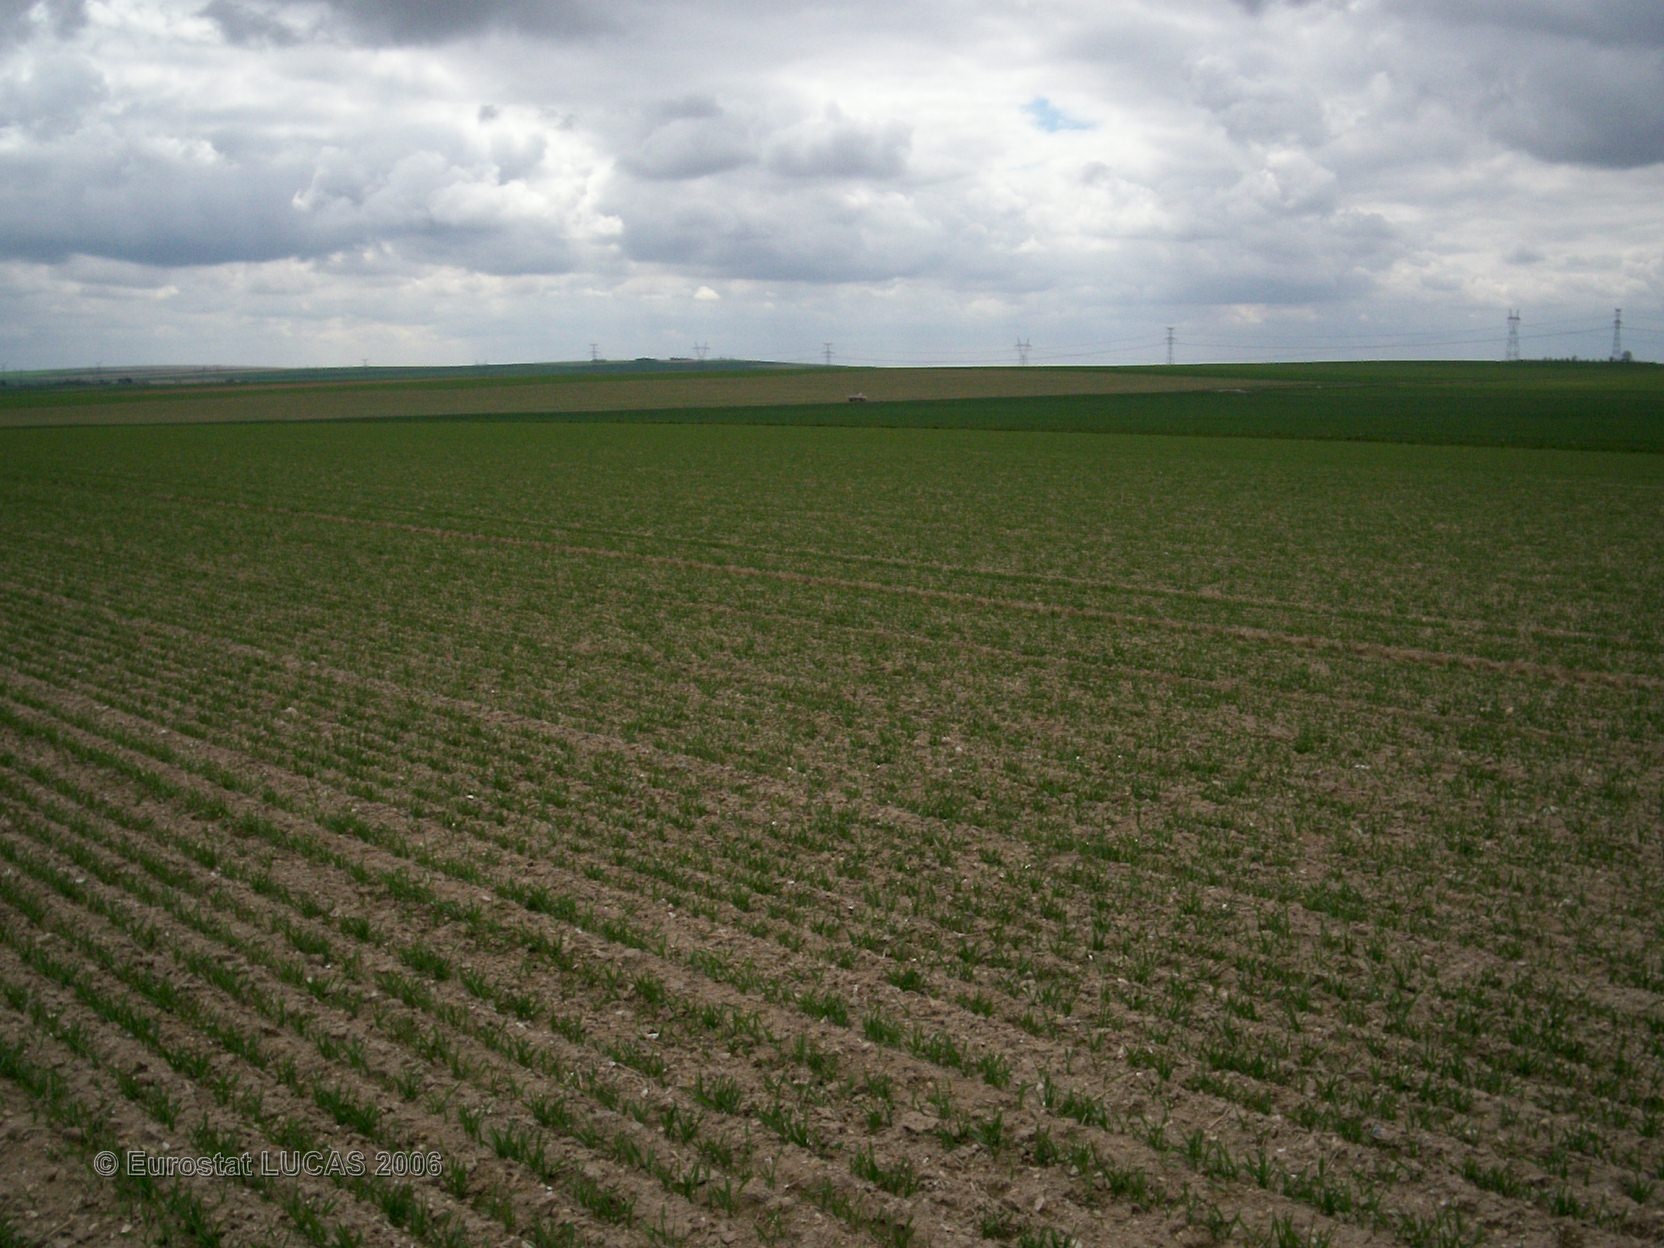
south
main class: Cropland
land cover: Barley
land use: Agriculture (excluding fallow land and kitchen gardens)
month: April
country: FR
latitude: 48.4918
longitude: 3.9742
